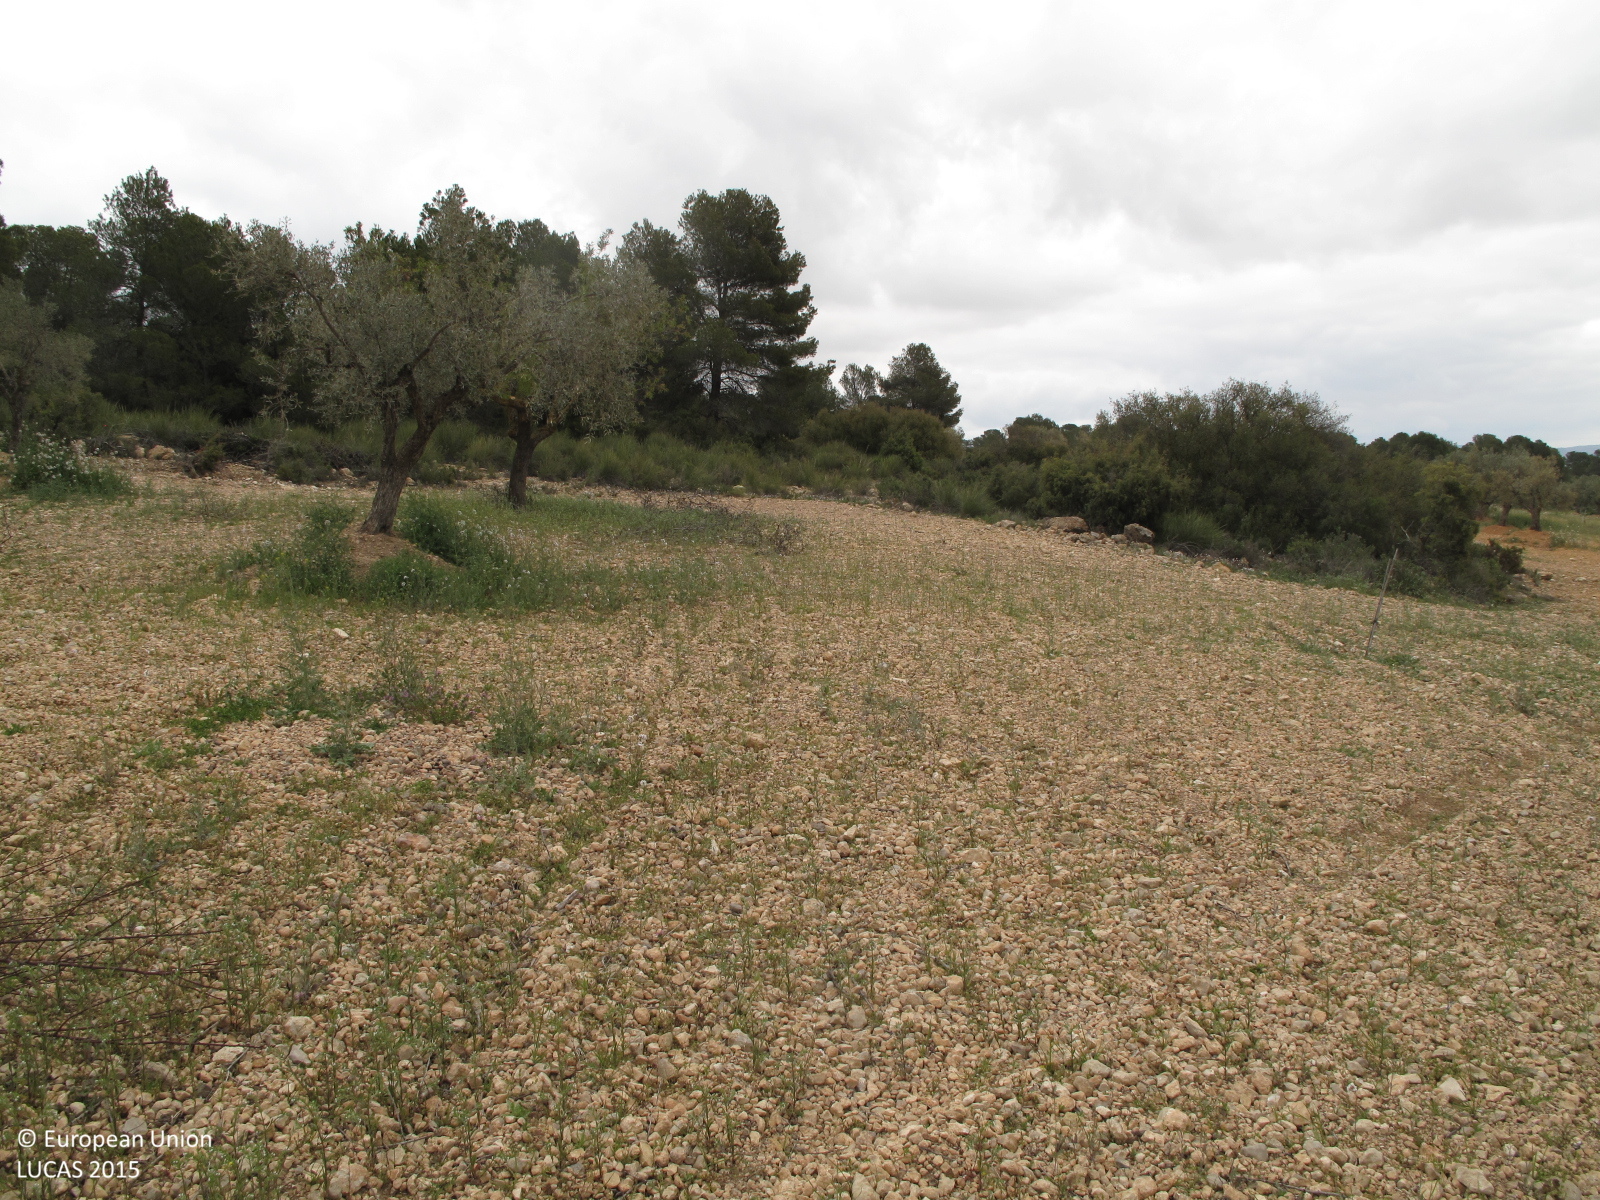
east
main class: Cropland
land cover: Olive groves
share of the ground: 25 - 50 %
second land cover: Nuts trees
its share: 25 - 50 %
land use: Agriculture (excluding fallow land and kitchen gardens)
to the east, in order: Olive groves; Nuts trees; Pine dominated coniferous woodland; Olive groves; Shrubland with sparse tree cover; Pine dominated coniferous woodland; Olive groves; Pine dominated coniferous woodland
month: April
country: ES
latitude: 38.7724
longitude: -0.9844
